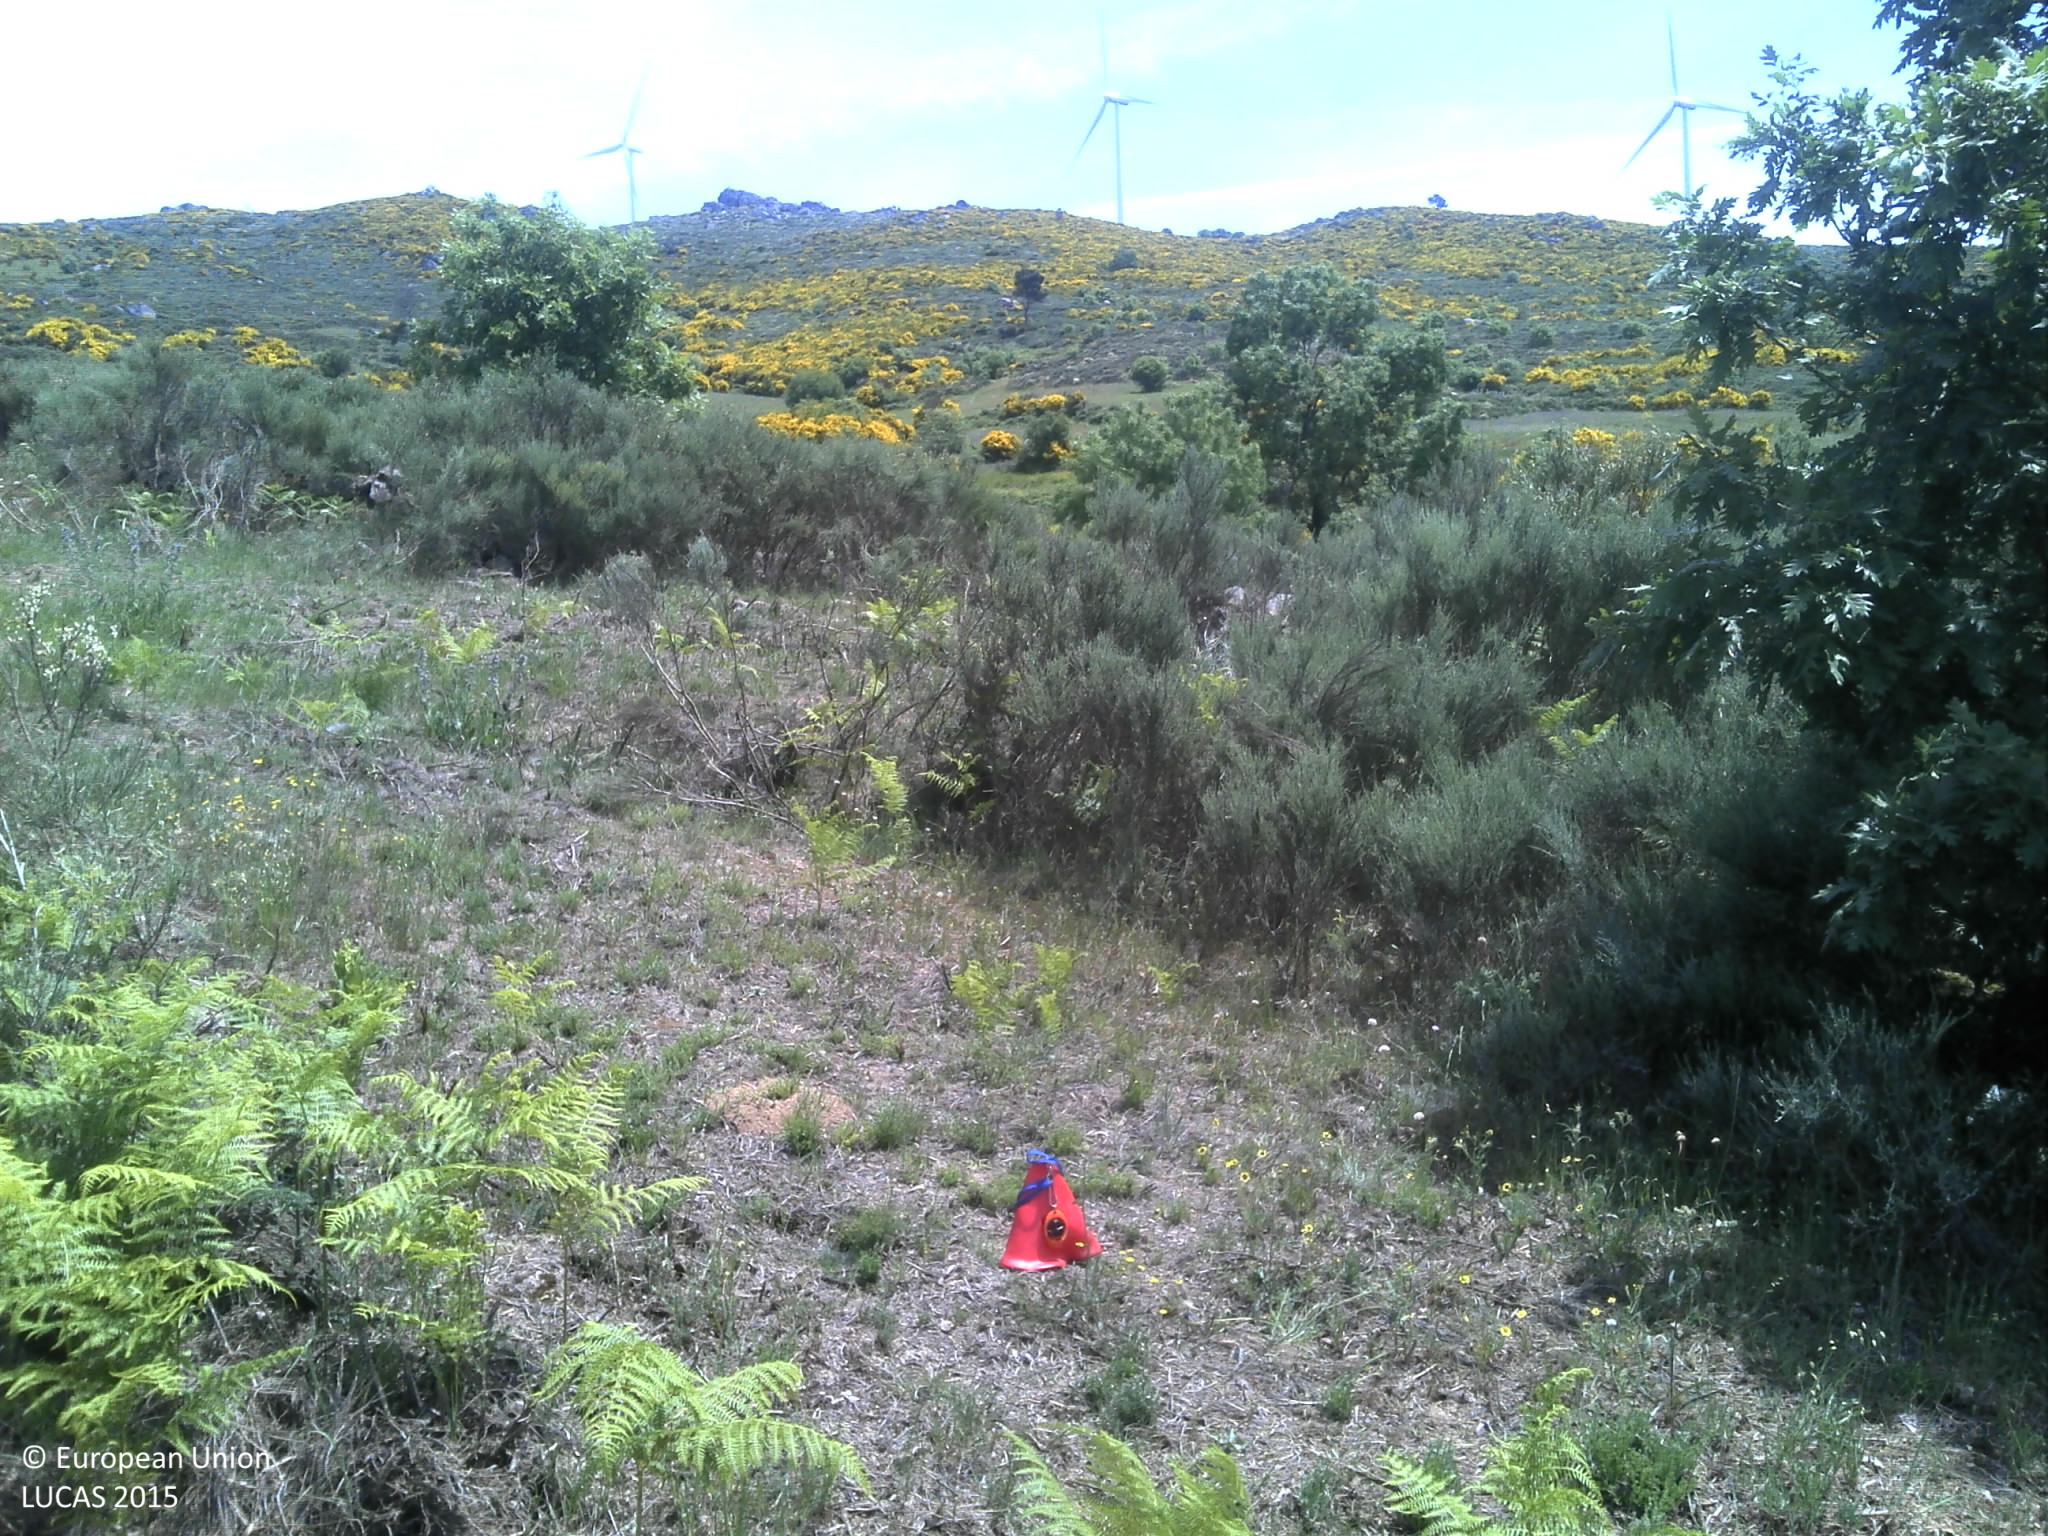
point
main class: Shrubland
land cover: Shrubland without tree cover
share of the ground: 50 - 75 %
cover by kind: shrubs 50 %, unconsolidated bare surface 40 %, herbaceous plants 10 %
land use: Abandoned areas
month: May
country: PT
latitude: 40.5780
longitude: -7.4169
